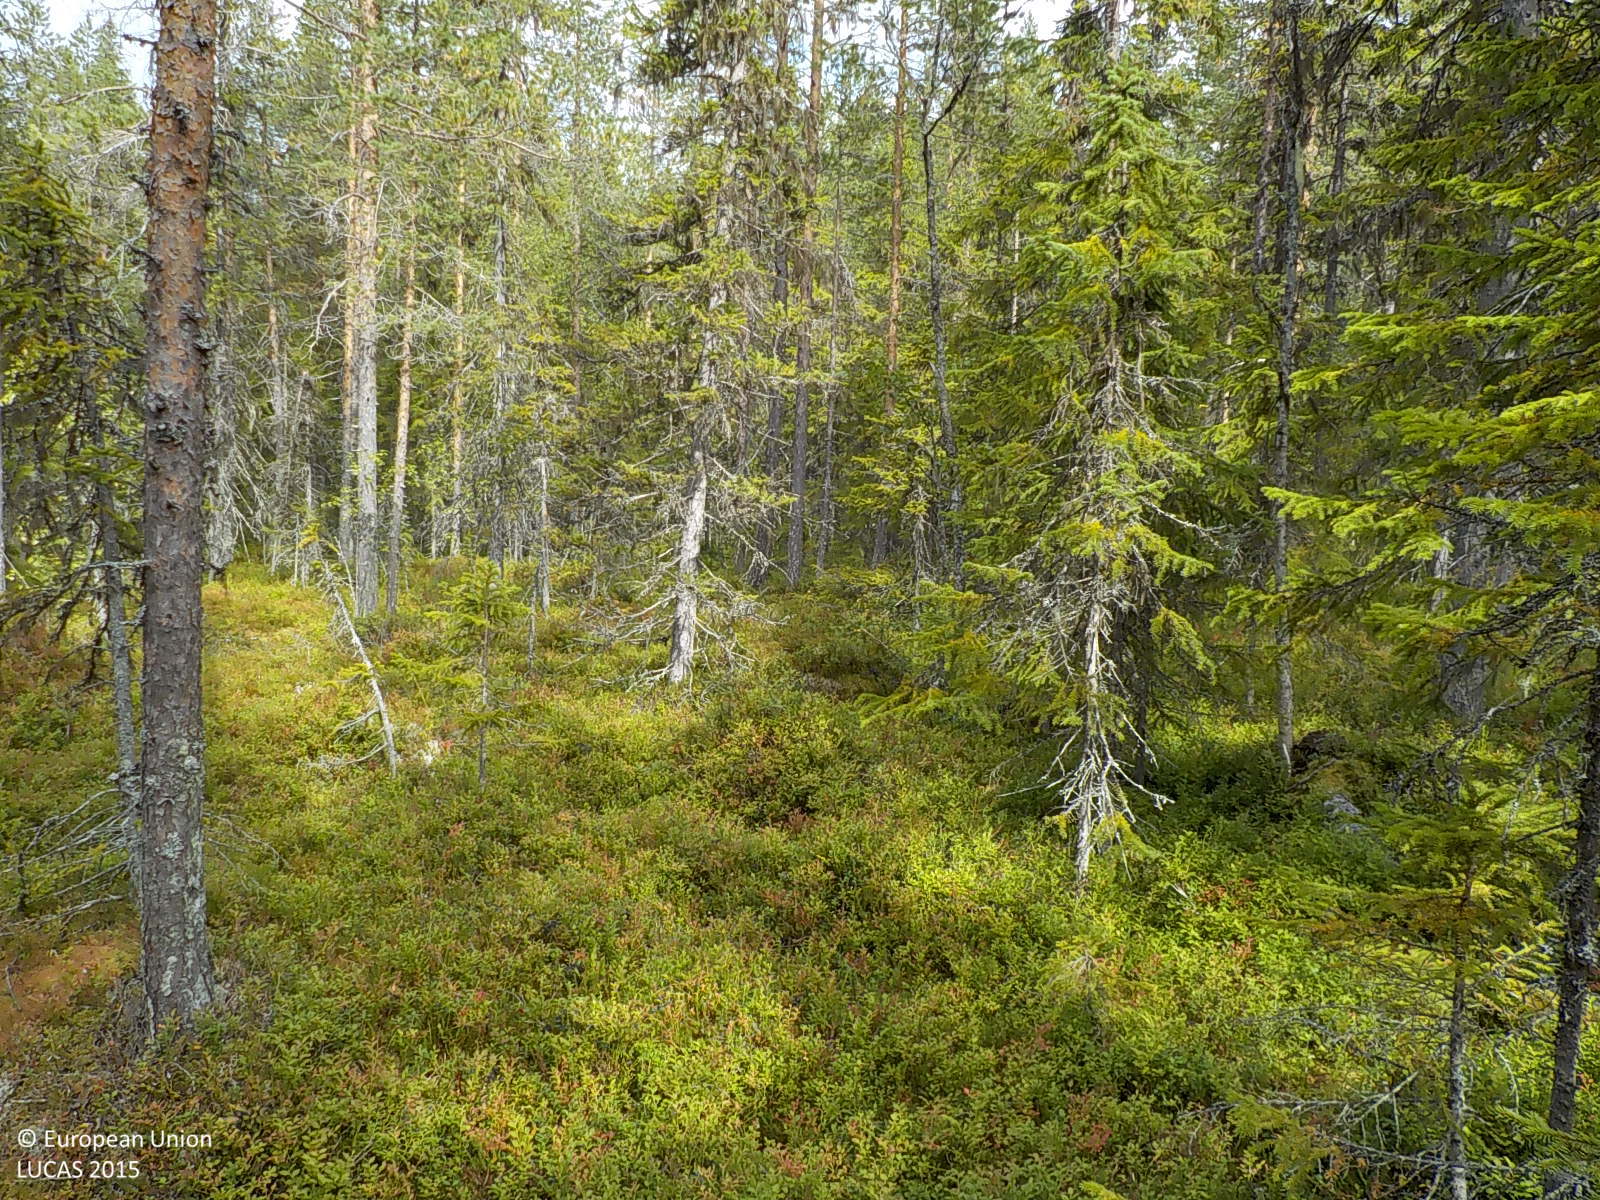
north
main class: Woodland
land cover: Pine dominated coniferous woodland
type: boreal forest
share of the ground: 50 - 75 %
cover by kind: coniferous forest trees 65 %, shrubs 35 %
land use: Forestry
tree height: > 5 m
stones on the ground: 25 - 50 %
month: September
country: SE
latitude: 63.3788
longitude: 17.2757
